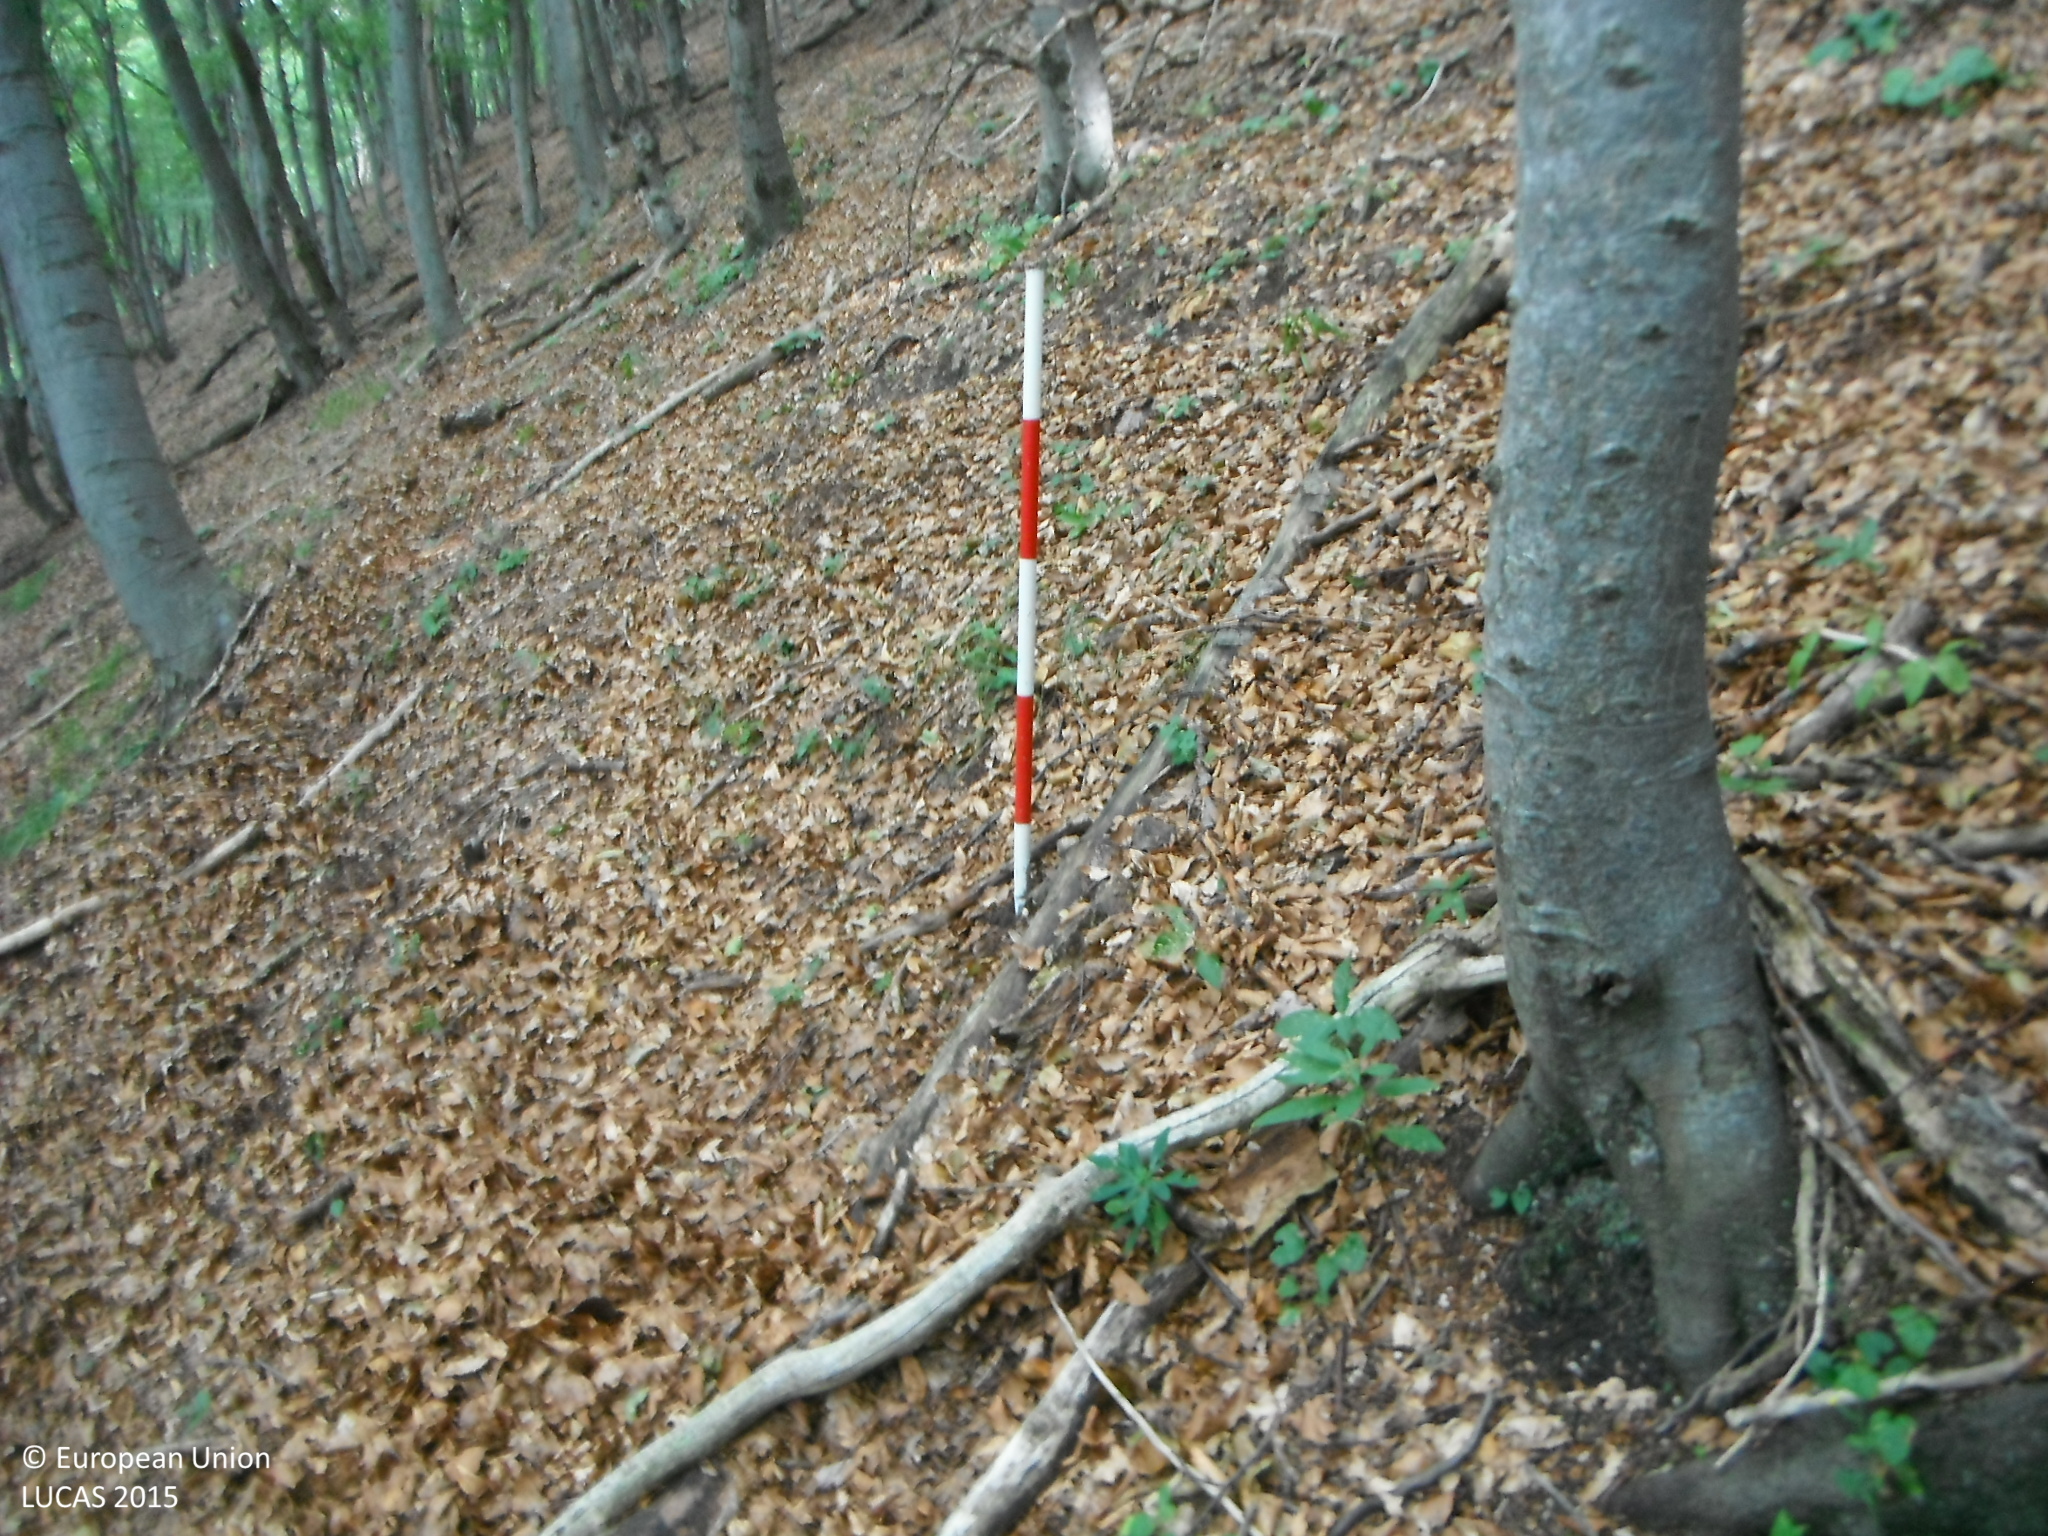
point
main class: Woodland
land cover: Broadleaved woodland
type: mountainous beech forest
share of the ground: > 75 %
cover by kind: broadleaved forest trees 85 %, herbaceous plants 5 %, consolidated bare surface 5 %
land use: Forestry
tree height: > 5 m
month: September
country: SK
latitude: 48.9189
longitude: 18.3547
